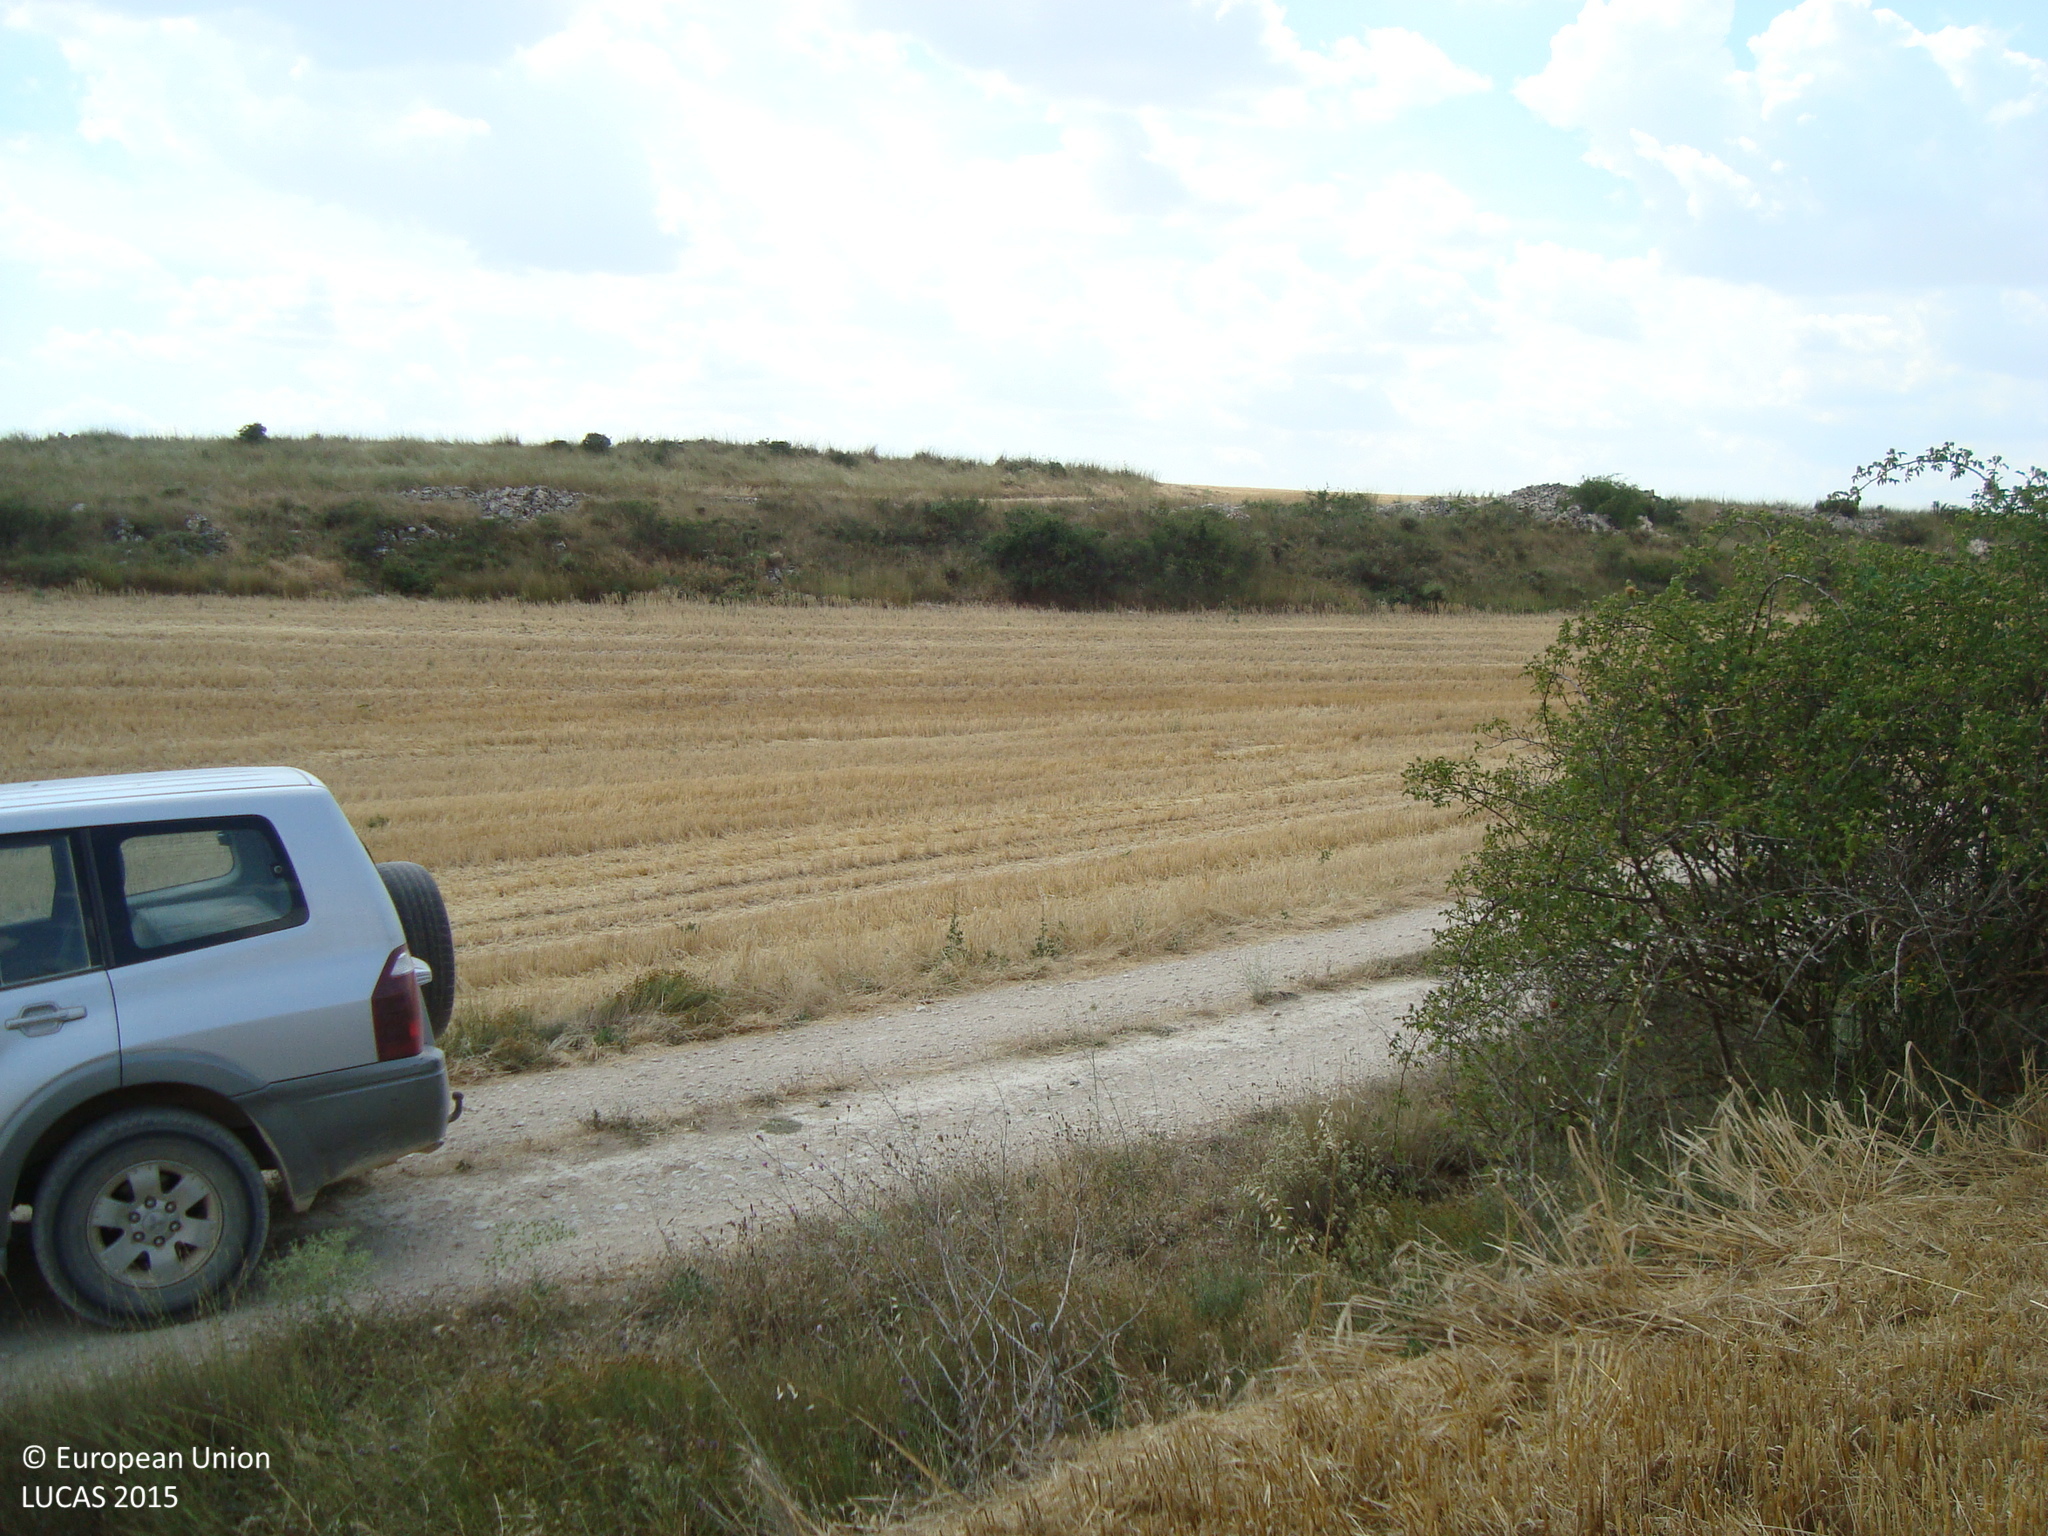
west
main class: Cropland
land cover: Barley
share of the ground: > 75 %
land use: Agriculture (excluding fallow land and kitchen gardens)
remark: Harvested field
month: July
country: ES
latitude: 41.9559
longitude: -4.0932
